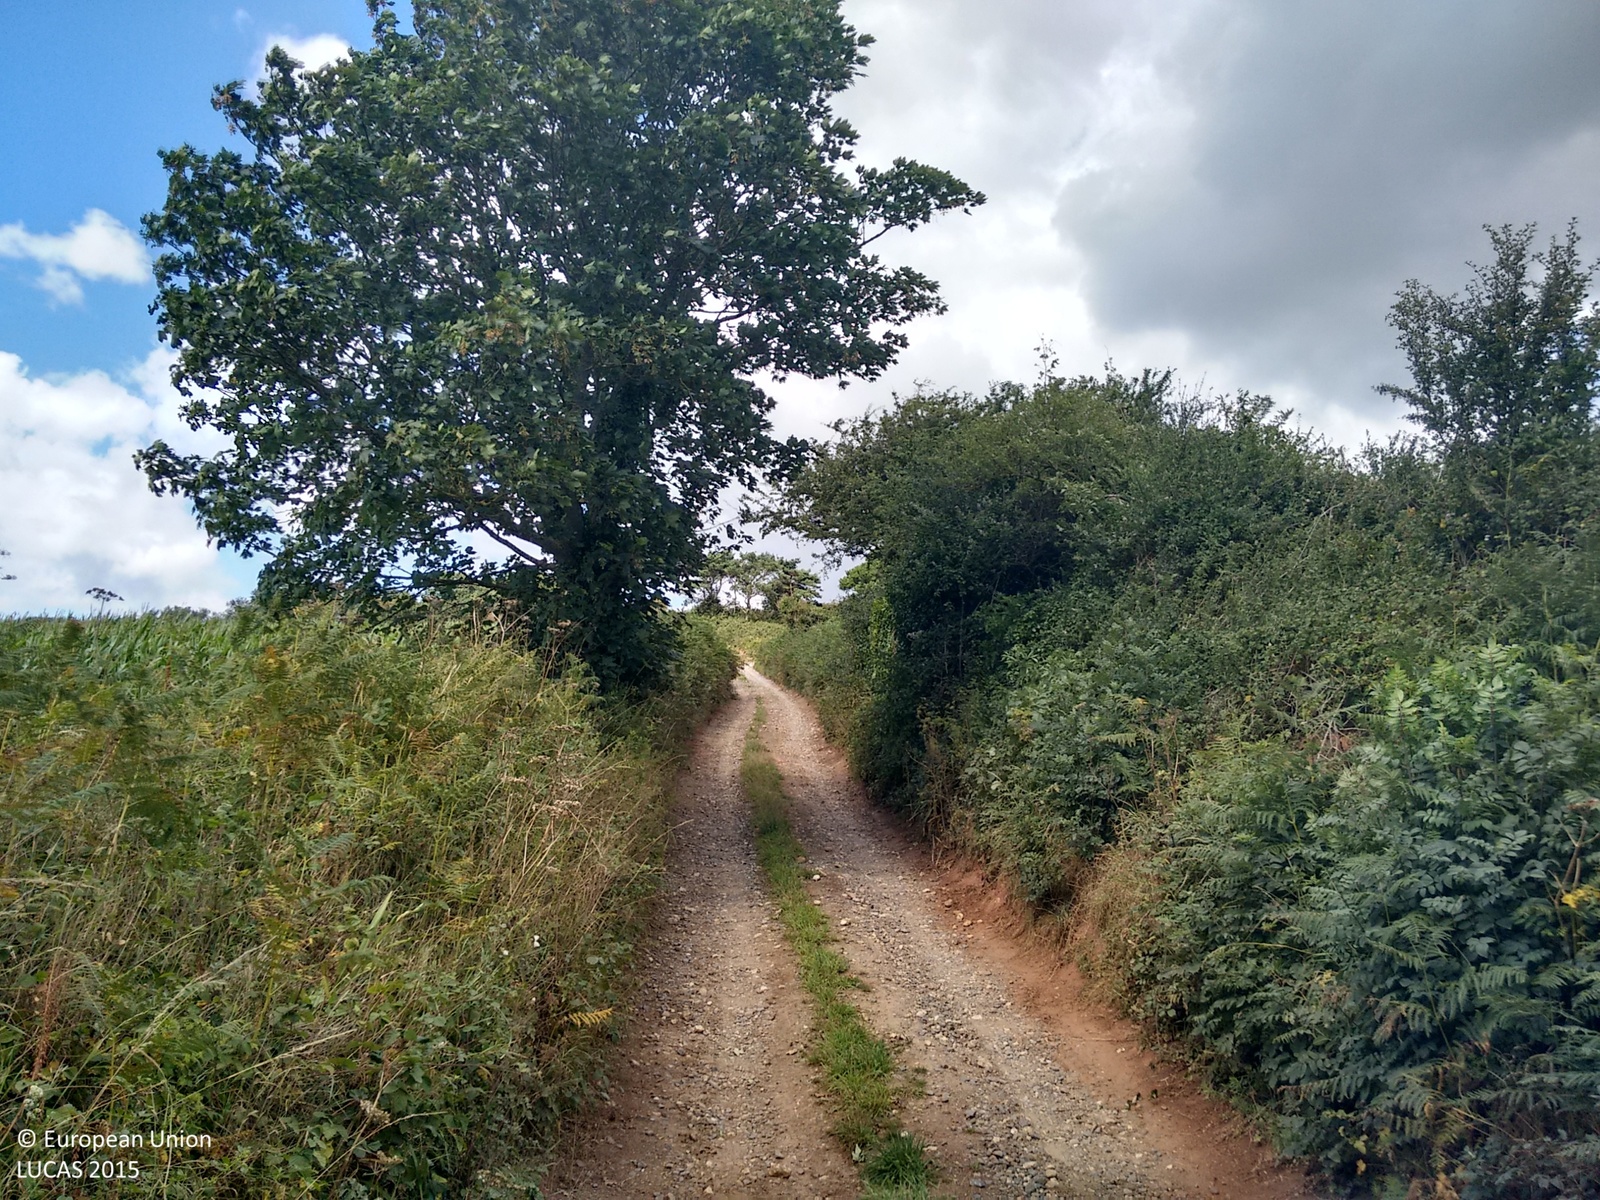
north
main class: Cropland
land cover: Maize
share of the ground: > 75 %
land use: Agriculture (excluding fallow land and kitchen gardens)
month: July
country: GB
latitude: 50.6401
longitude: -3.3013
